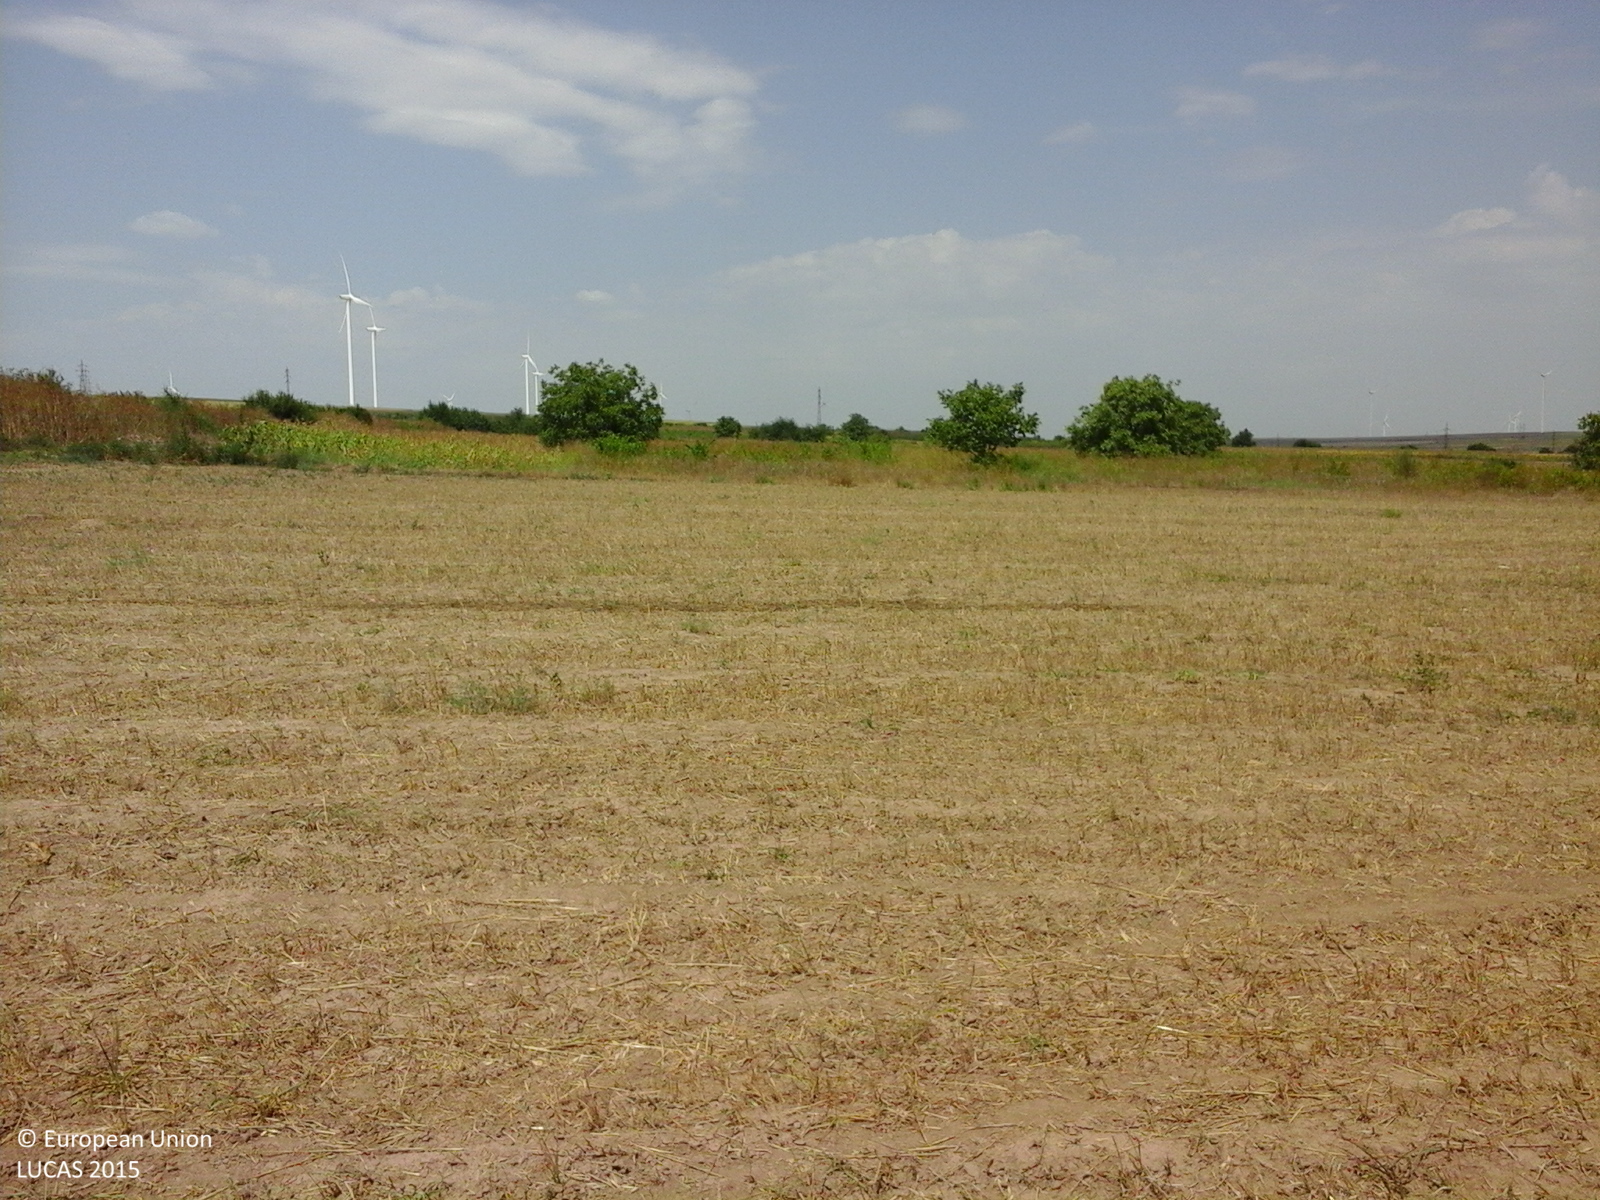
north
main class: Cropland
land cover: Oats
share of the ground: 25 - 50 %
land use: Agriculture (excluding fallow land and kitchen gardens)
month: August
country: RO
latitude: 44.2804
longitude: 28.1661
